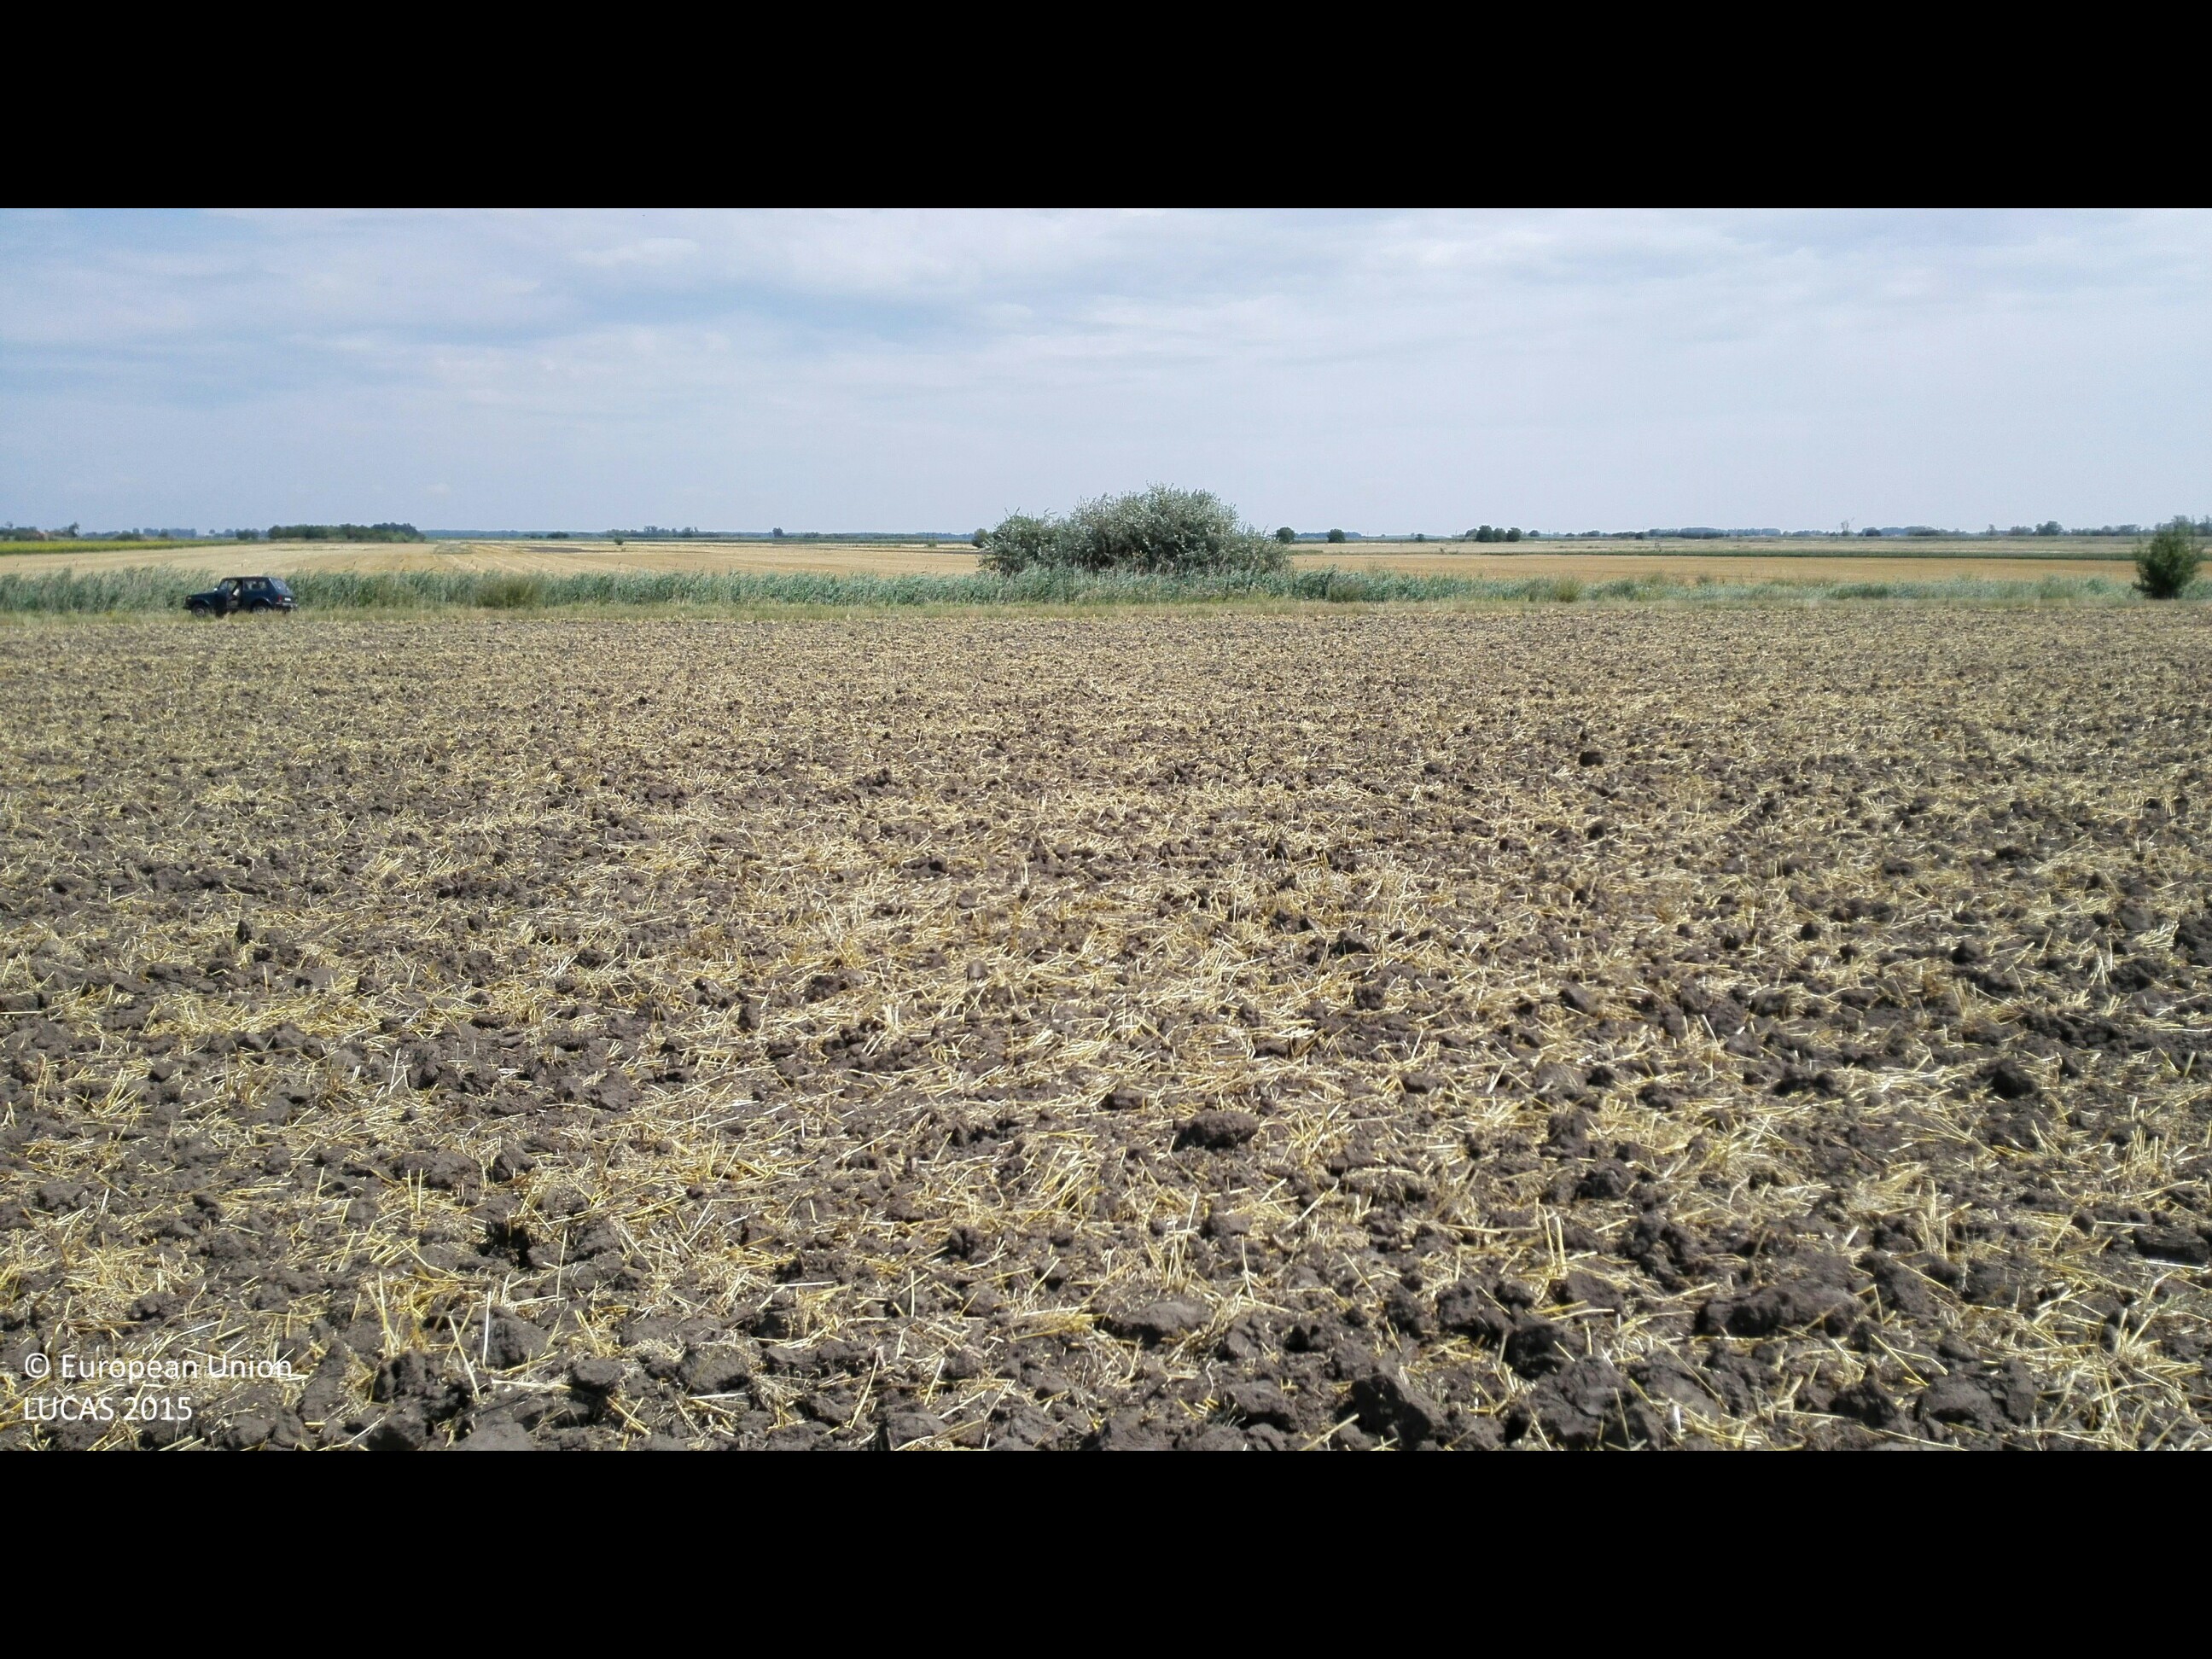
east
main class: Cropland
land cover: Barley
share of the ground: < 10 %
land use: Agriculture (excluding fallow land and kitchen gardens)
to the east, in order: Barley; Tracks; Ditches and canals; Common wheat
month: July
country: HU
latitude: 47.2400
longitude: 21.3075
